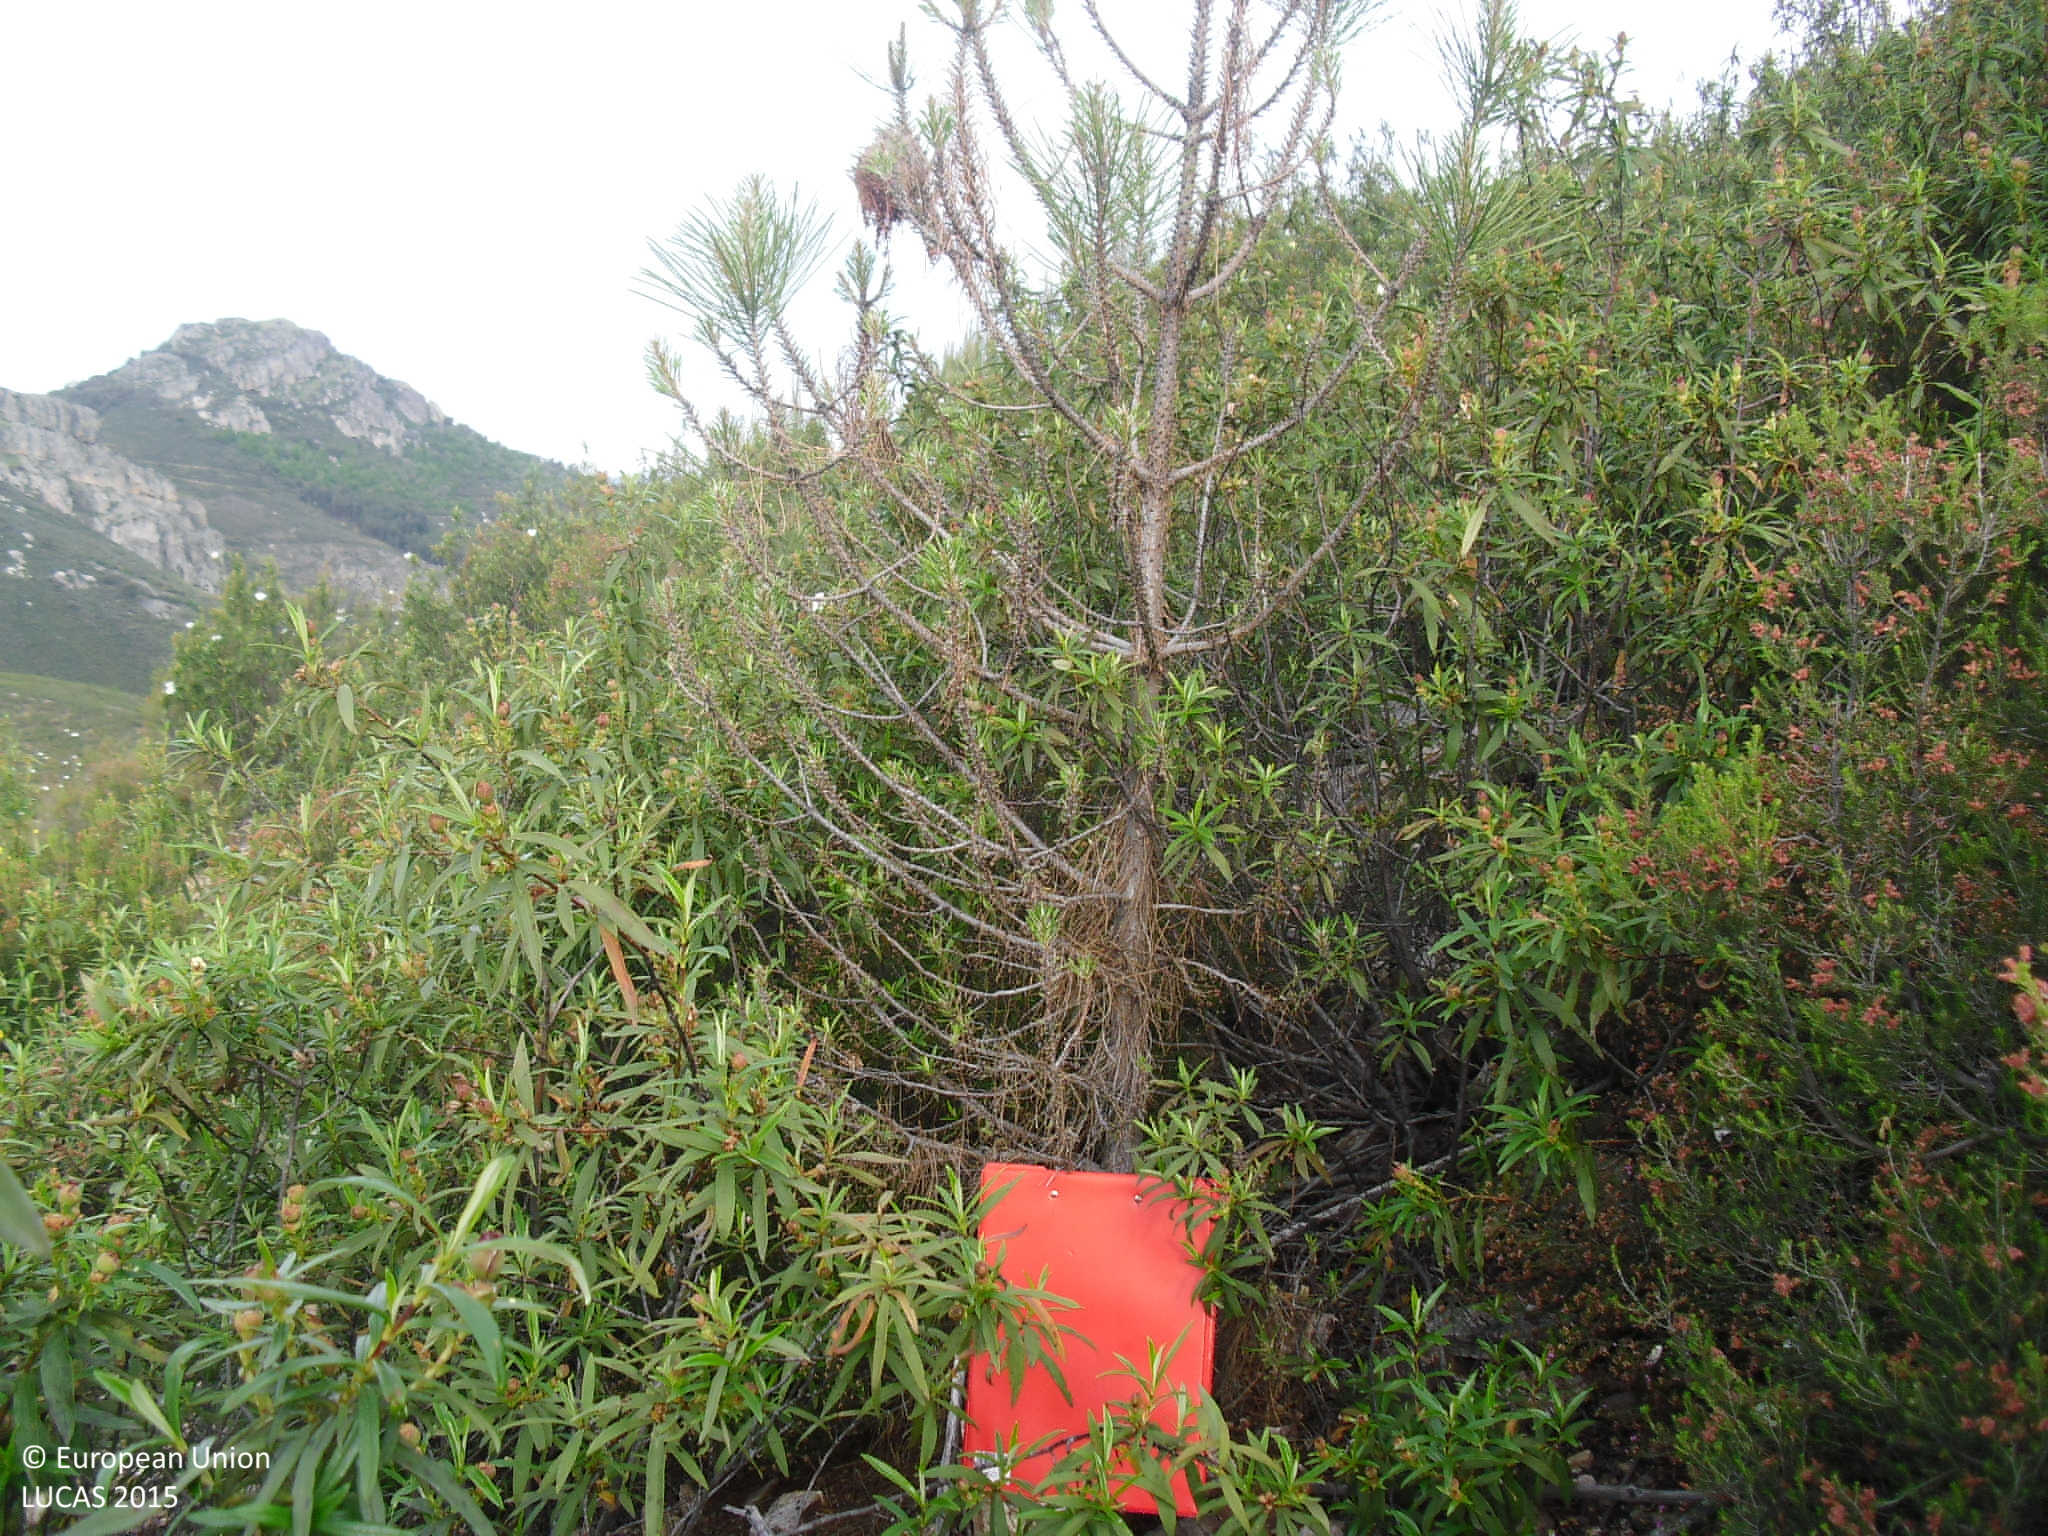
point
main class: Shrubland
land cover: Shrubland with sparse tree cover
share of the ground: > 75 %
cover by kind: shrubs 80 %, unconsolidated bare surface 15 %, broadleaved forest trees 5 %
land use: Semi-natural and natural areas not in use
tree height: < 5 m
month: May
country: ES
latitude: 39.3806
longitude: -5.3600
